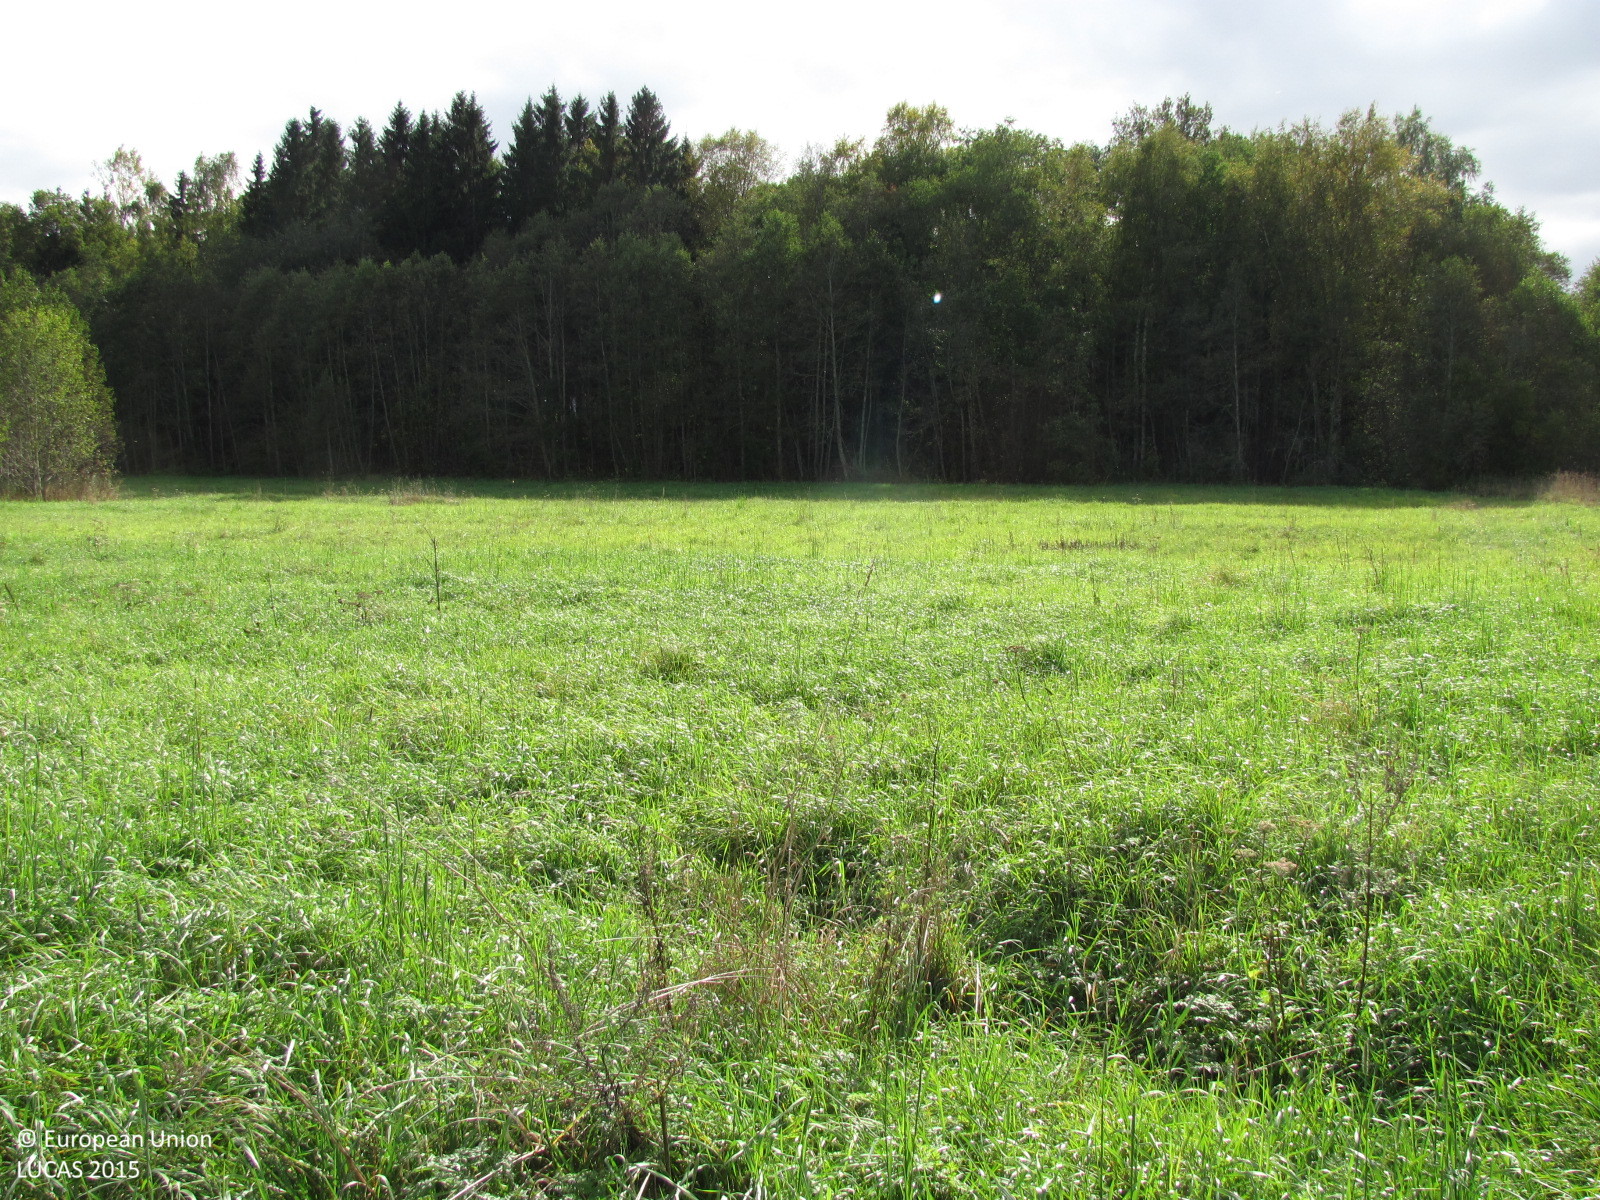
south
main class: Grassland
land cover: Grassland without tree/shrub cover
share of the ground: > 75 %
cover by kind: herbaceous plants 100 %
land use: Agriculture (excluding fallow land and kitchen gardens)
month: September
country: LV
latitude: 56.8328
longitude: 25.2056
